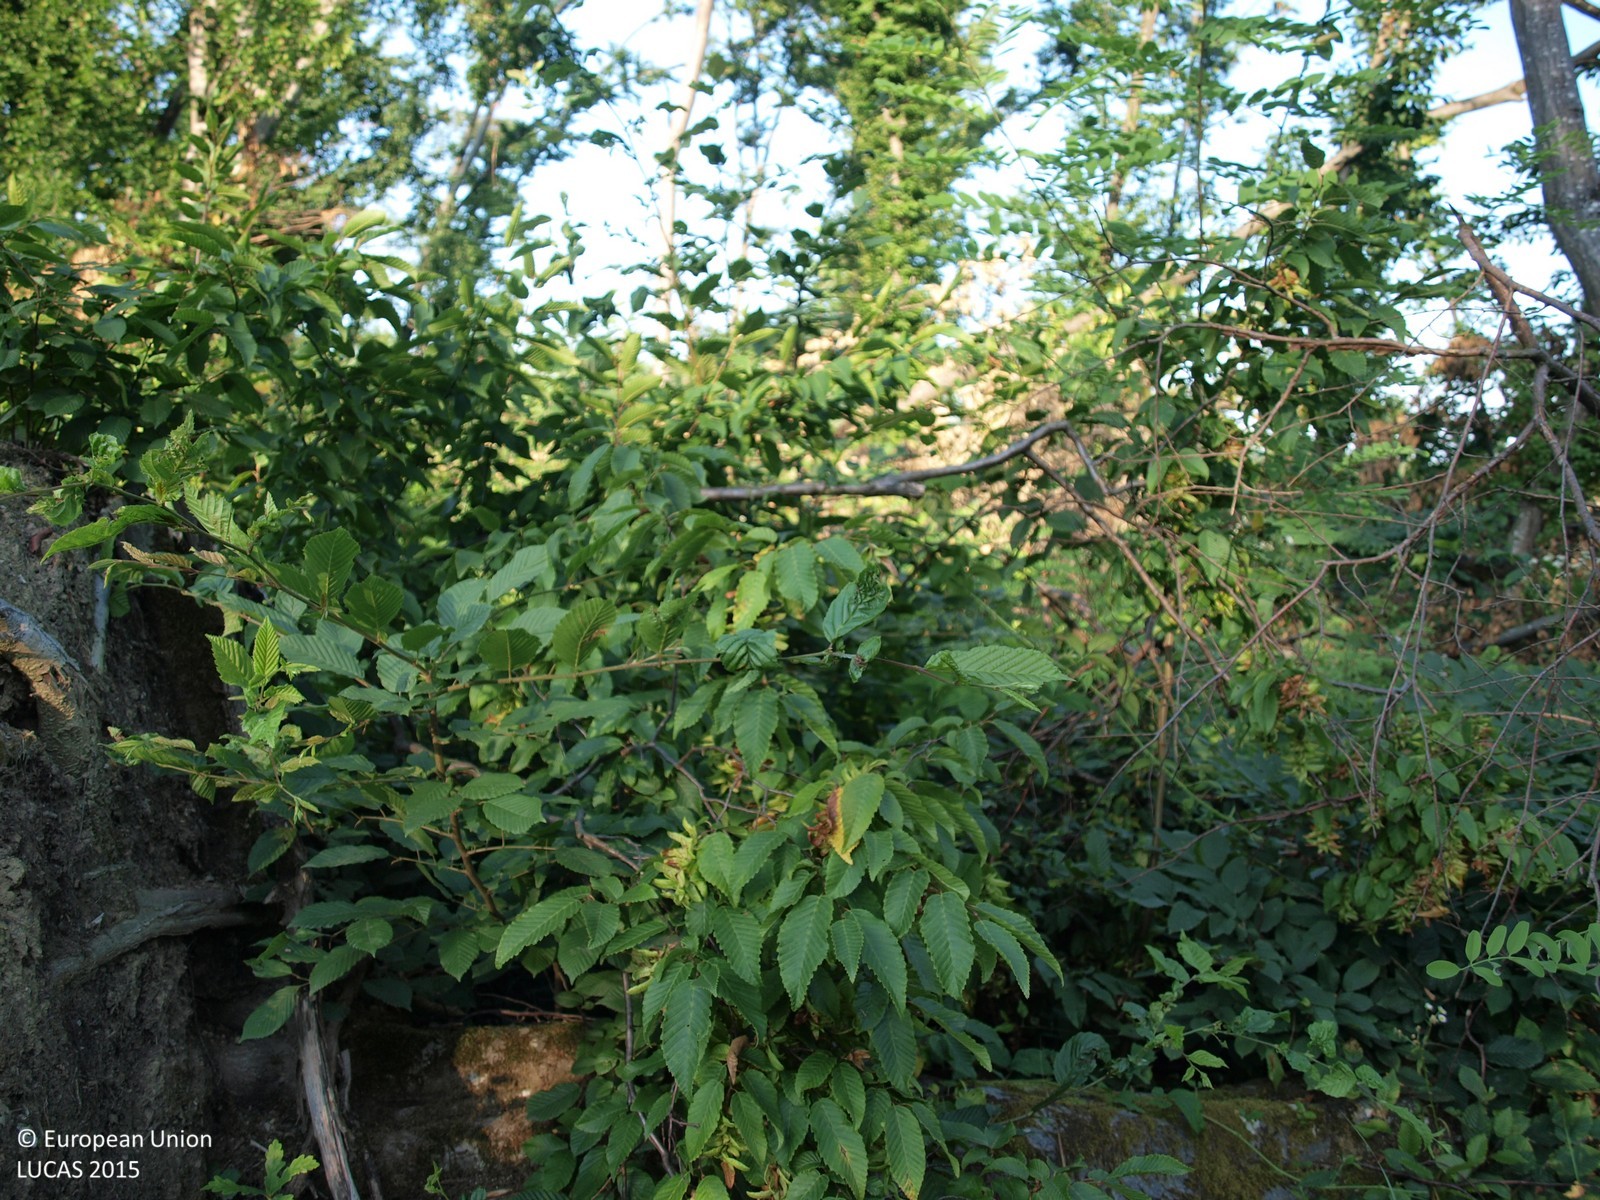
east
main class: Woodland
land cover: Broadleaved woodland
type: mesophytic deciduous forest
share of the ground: > 75 %
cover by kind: broadleaved forest trees 90 %, shrubs 10 %
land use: Forestry
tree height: > 5 m
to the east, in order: Broadleaved woodland; Electric lines; Broadleaved woodland; Paved roads, cycling and walking lanes; Spontaneously vegetated surfaces
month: July
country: HR
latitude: 45.6791
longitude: 15.6329
